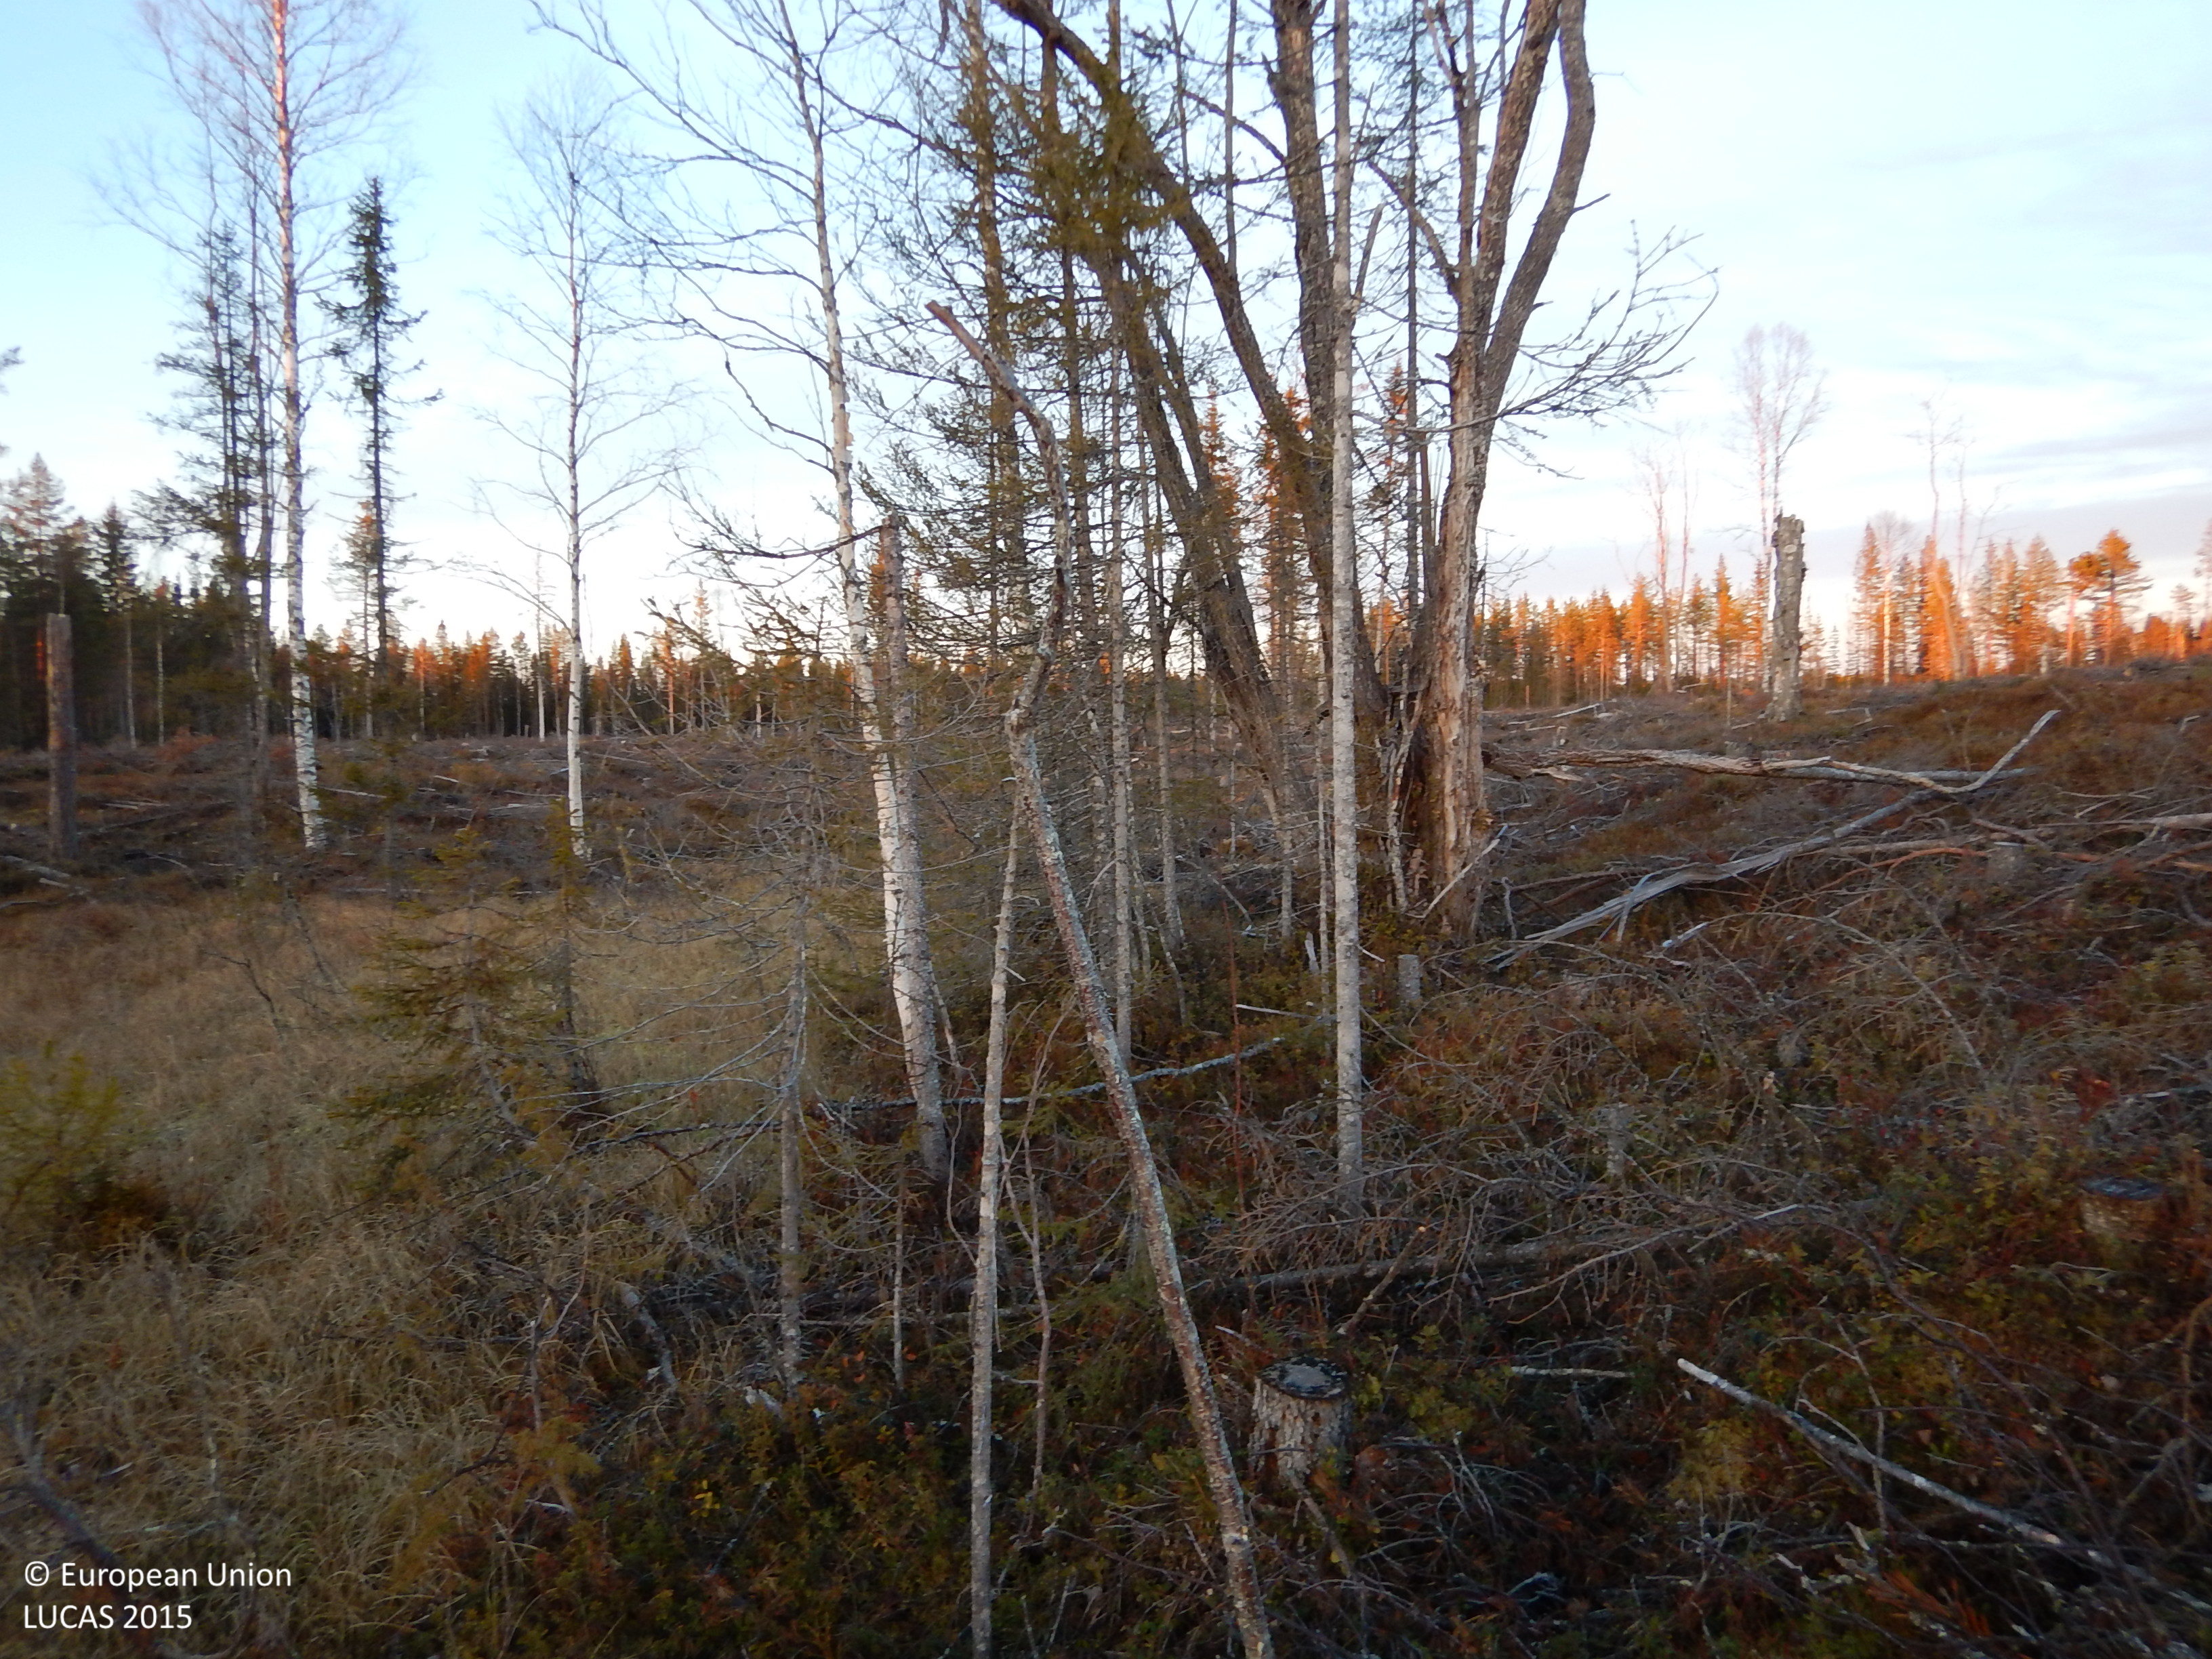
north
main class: Shrubland
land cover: Shrubland with sparse tree cover
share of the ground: 25 - 50 %
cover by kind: shrubs 40 %, herbaceous plants 25 %, lichens and mosses 20 %, coniferous forest trees 5 %
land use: Forestry
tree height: > 5 m
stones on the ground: < 10 %
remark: Clear cut
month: November
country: SE
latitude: 65.2115
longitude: 20.5944
